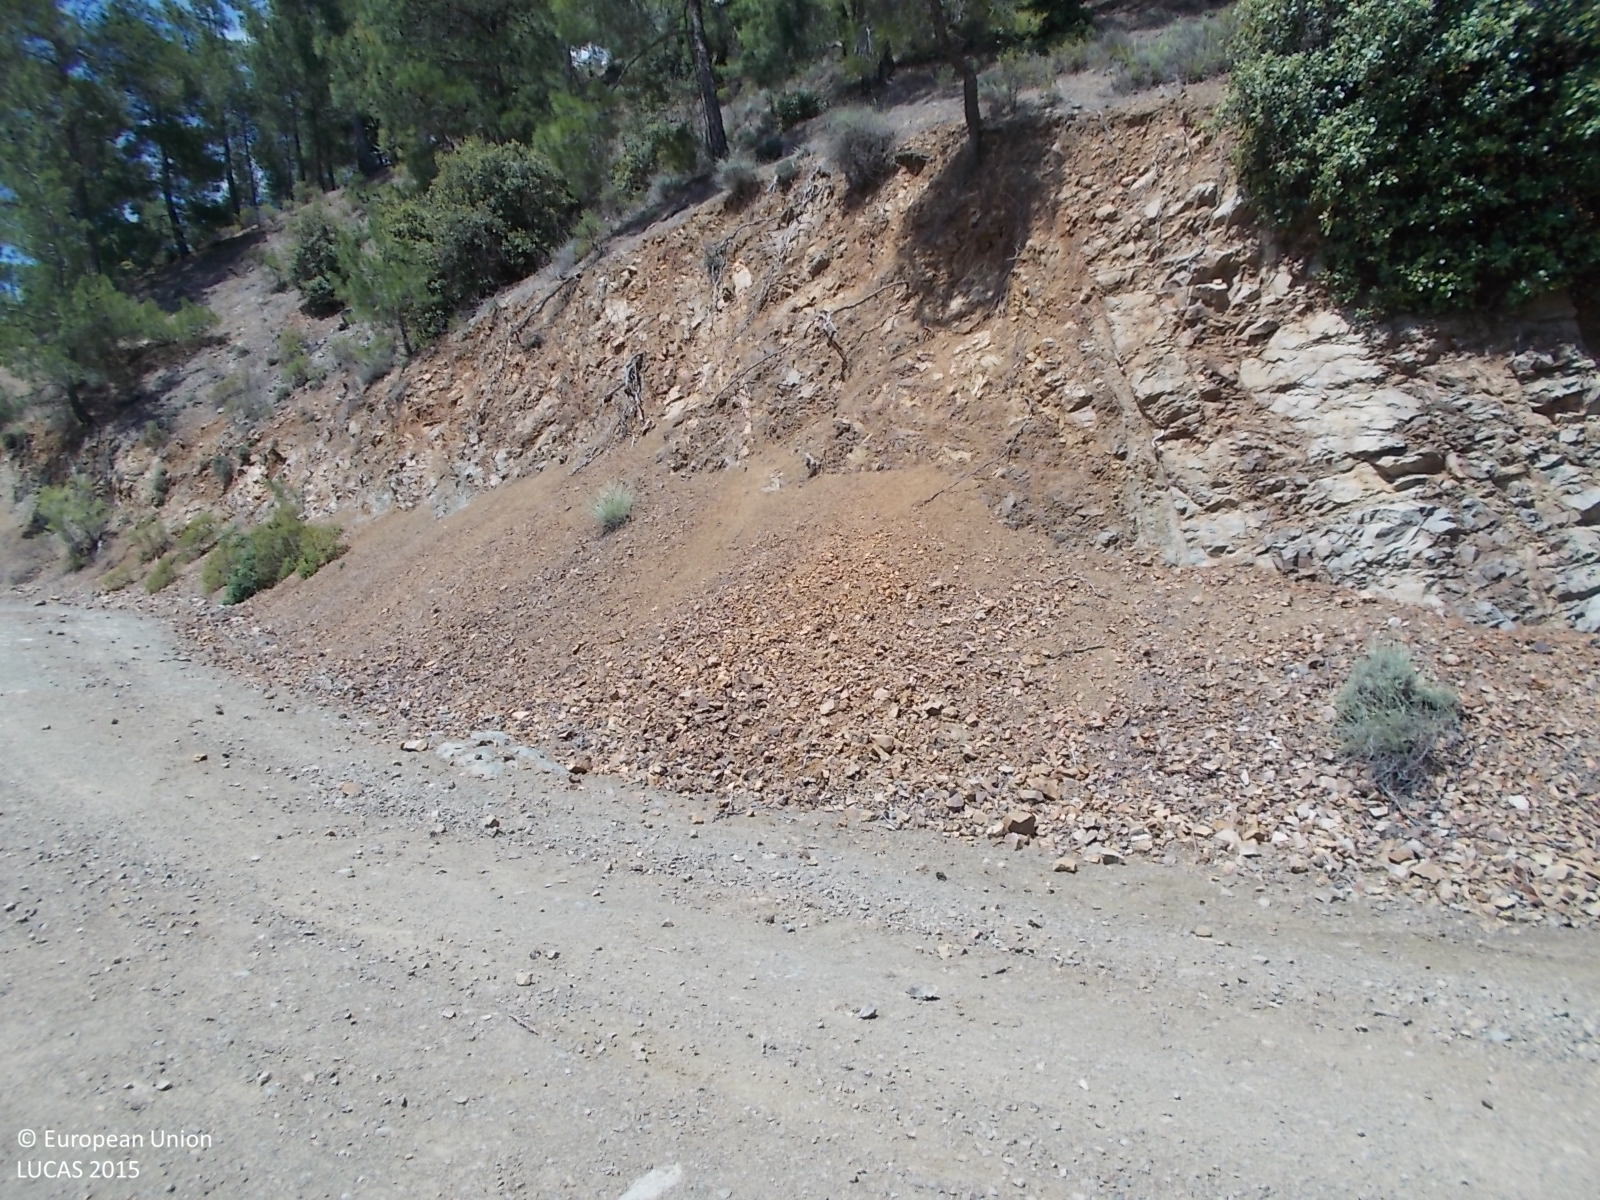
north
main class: Woodland
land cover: Pine dominated mixed woodland
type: coniferous forest of the mediterranean region
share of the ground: > 75 %
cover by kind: coniferous forest trees 50 %, broadleaved forest trees 25 %, unconsolidated bare surface 20 %, shrubs 5 %
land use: Forestry
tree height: > 5 m
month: June
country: CY
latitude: 34.9423
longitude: 32.6365
